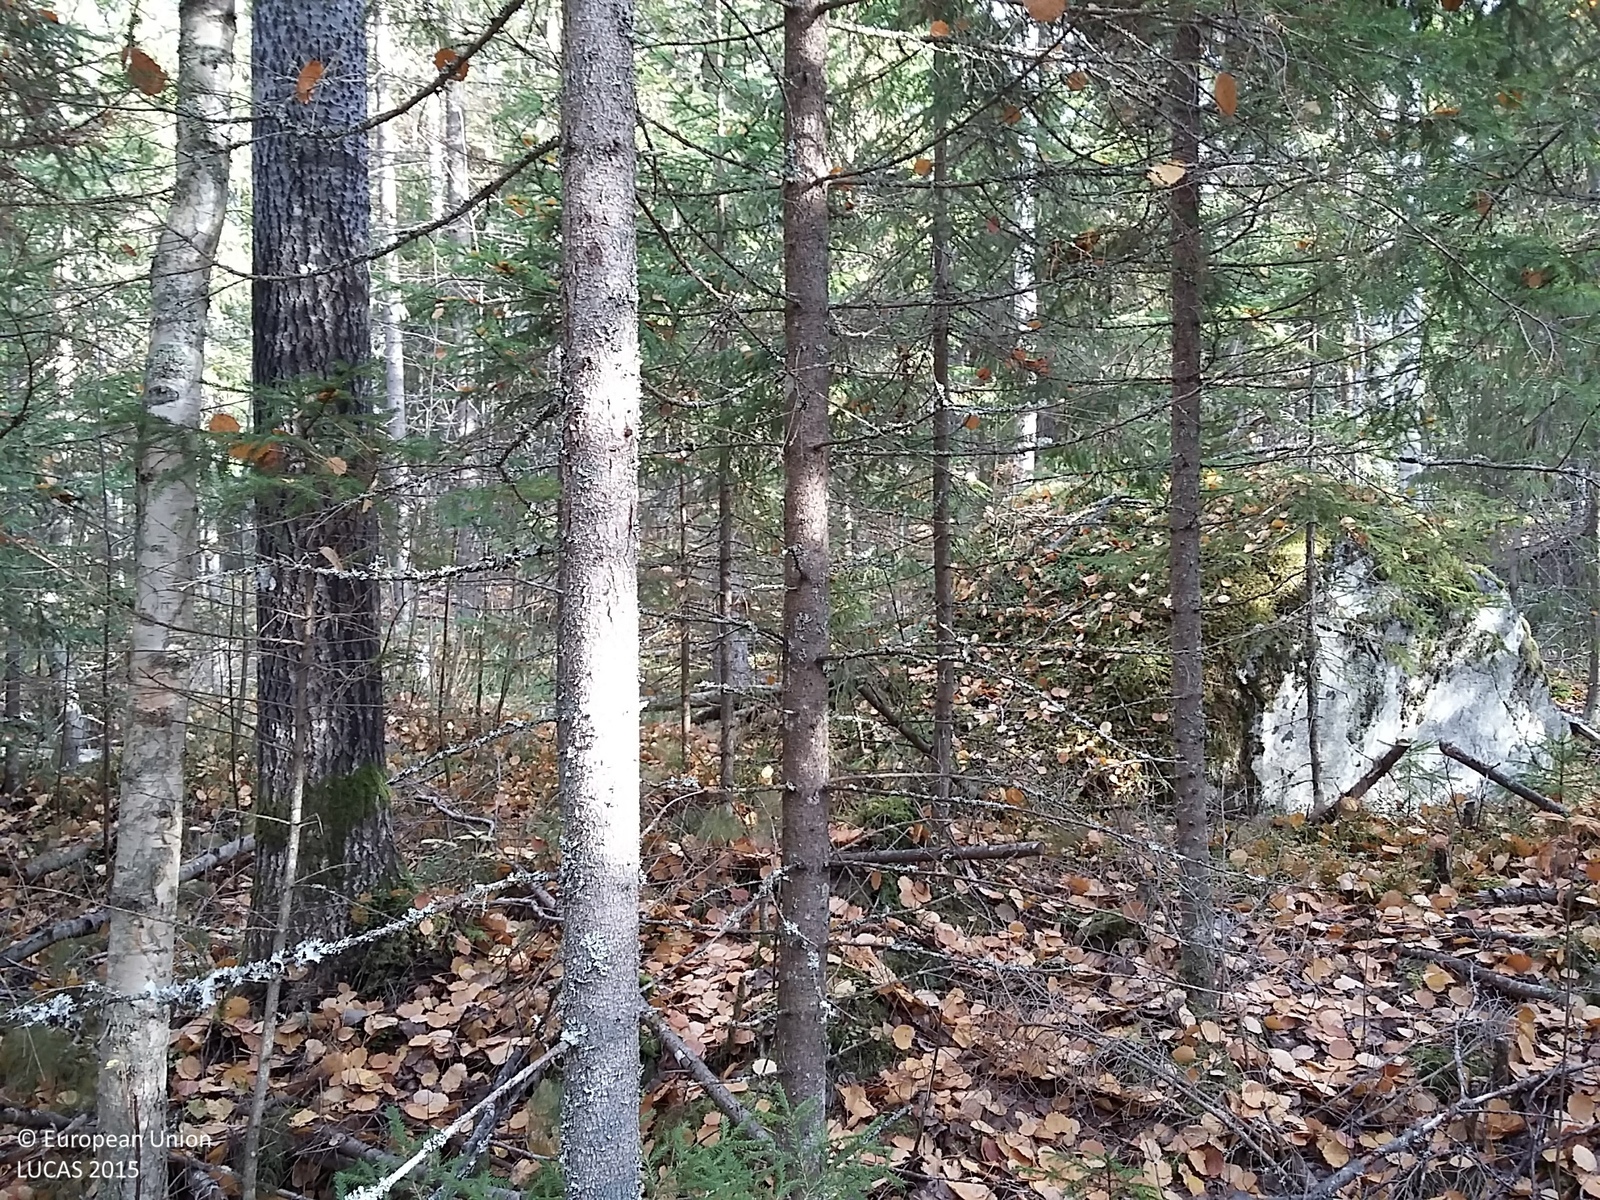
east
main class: Woodland
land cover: Spruce dominated mixed woodland
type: boreal forest
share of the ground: > 75 %
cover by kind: coniferous forest trees 45 %, broadleaved forest trees 40 %, herbaceous plants 10 %, lichens and mosses 5 %
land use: Forestry
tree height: > 5 m
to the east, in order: Spruce dominated mixed woodland; Spruce dominated coniferous woodland; Other mixed woodland; Pine dominated mixed woodland; Pine dominated coniferous woodland; Pine dominated mixed woodland; Other mixed woodland
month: October
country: FI
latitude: 62.7987
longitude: 26.0245
